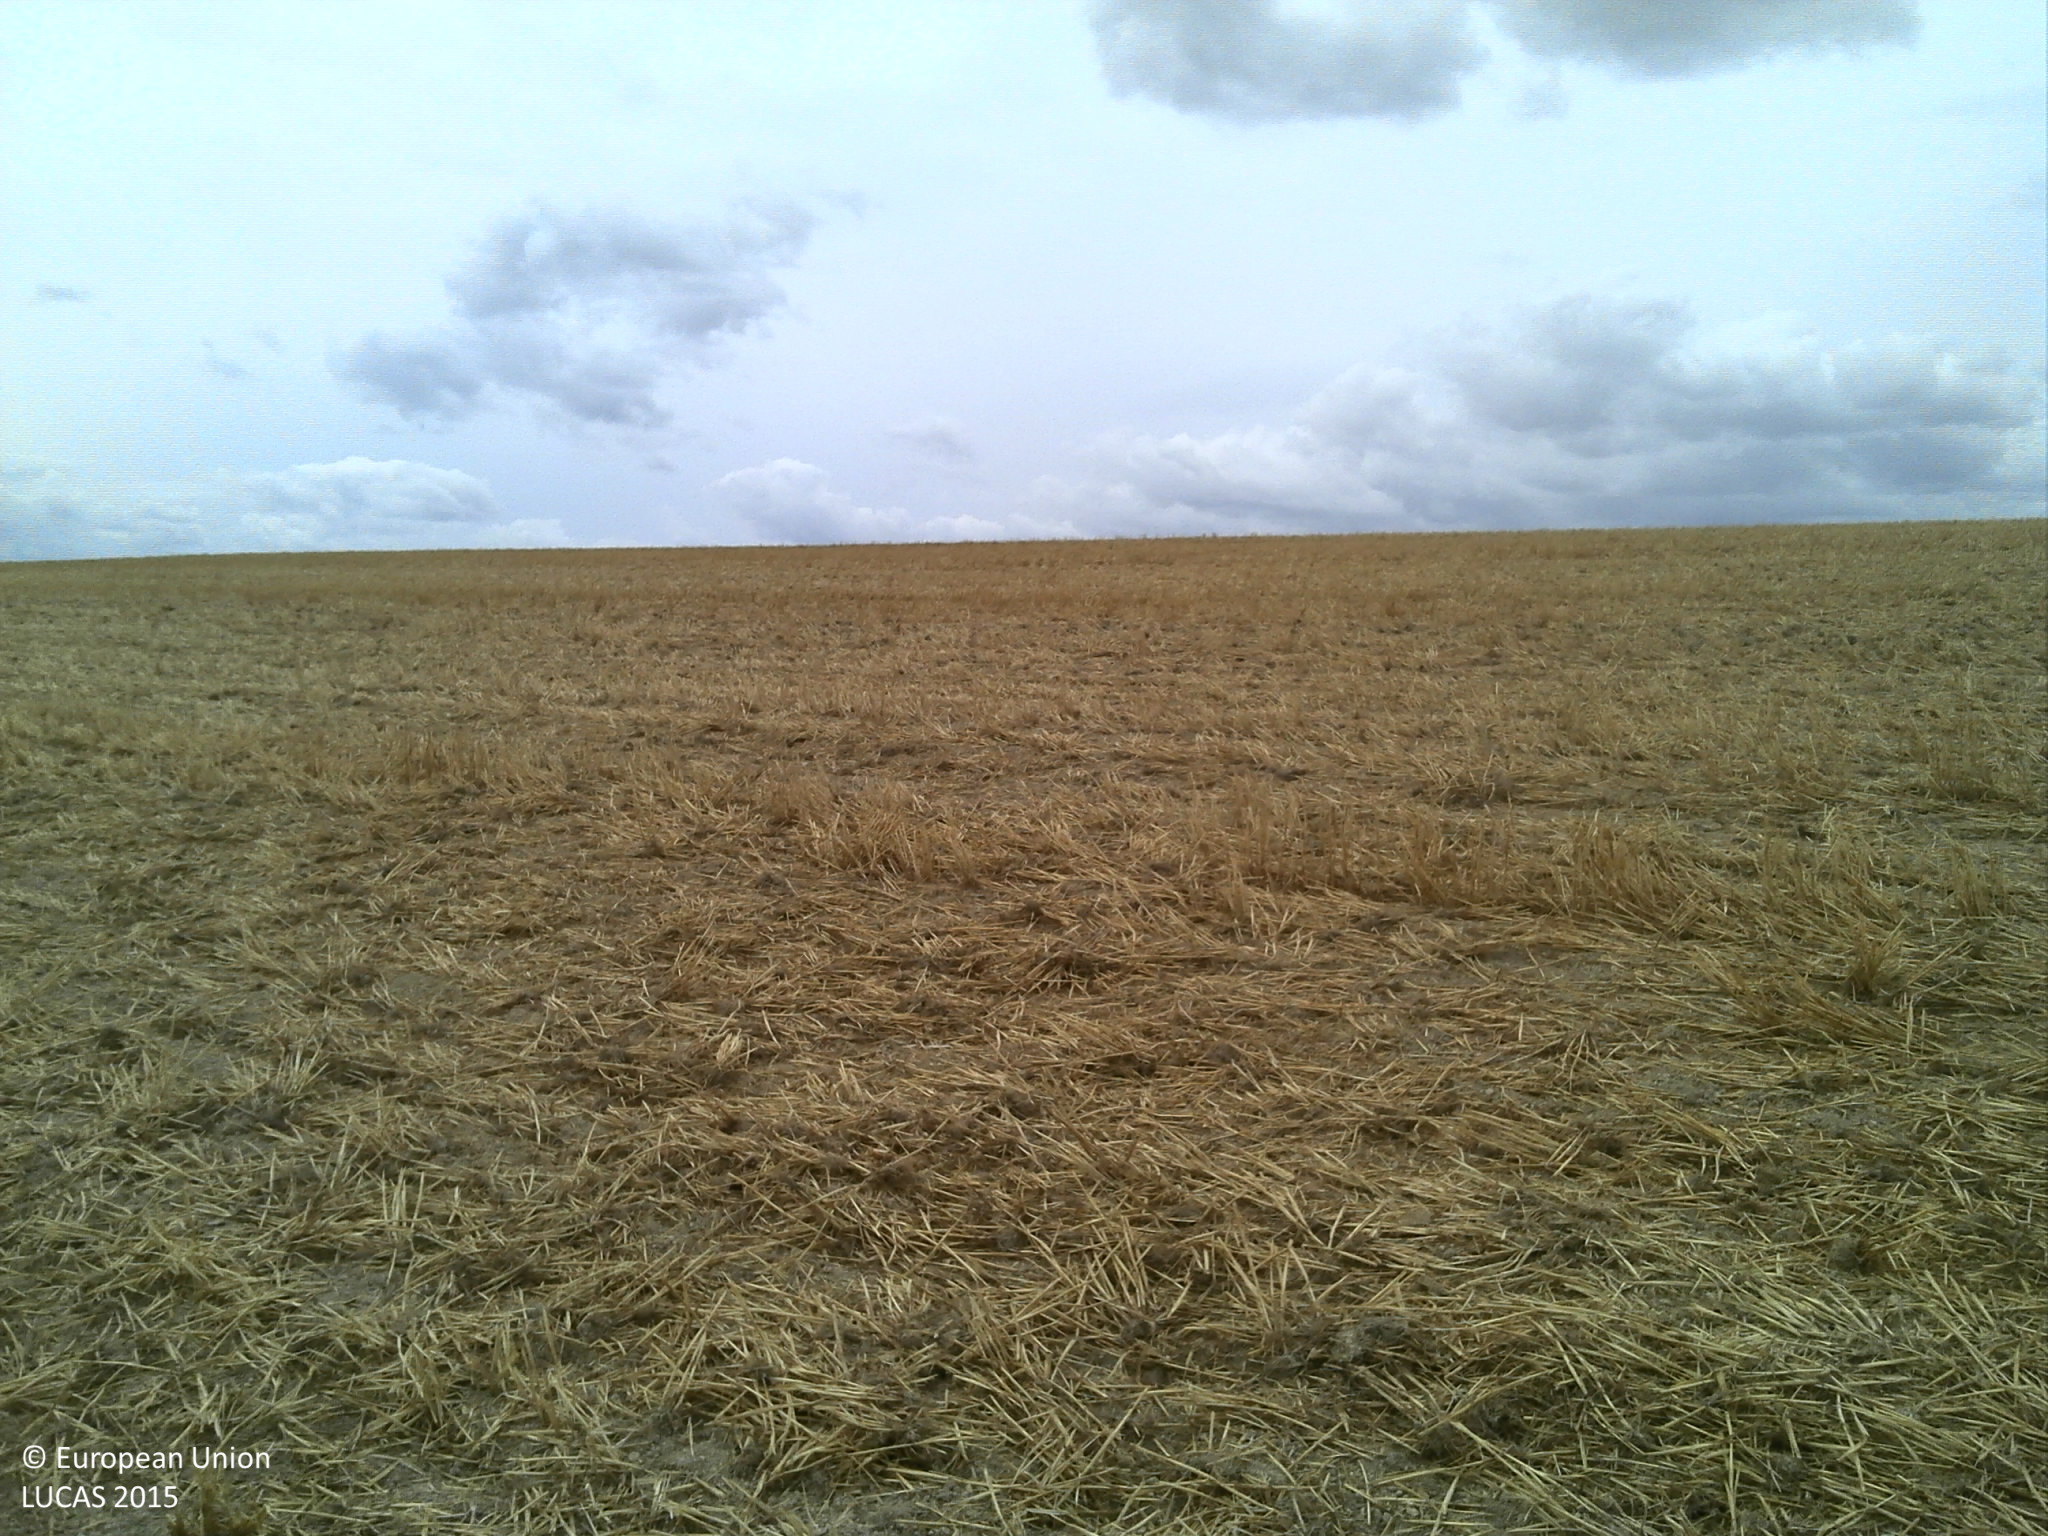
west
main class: Cropland
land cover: Common wheat
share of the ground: 25 - 50 %
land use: Agriculture (excluding fallow land and kitchen gardens)
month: July
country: FR
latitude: 49.5980
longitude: 4.0871
